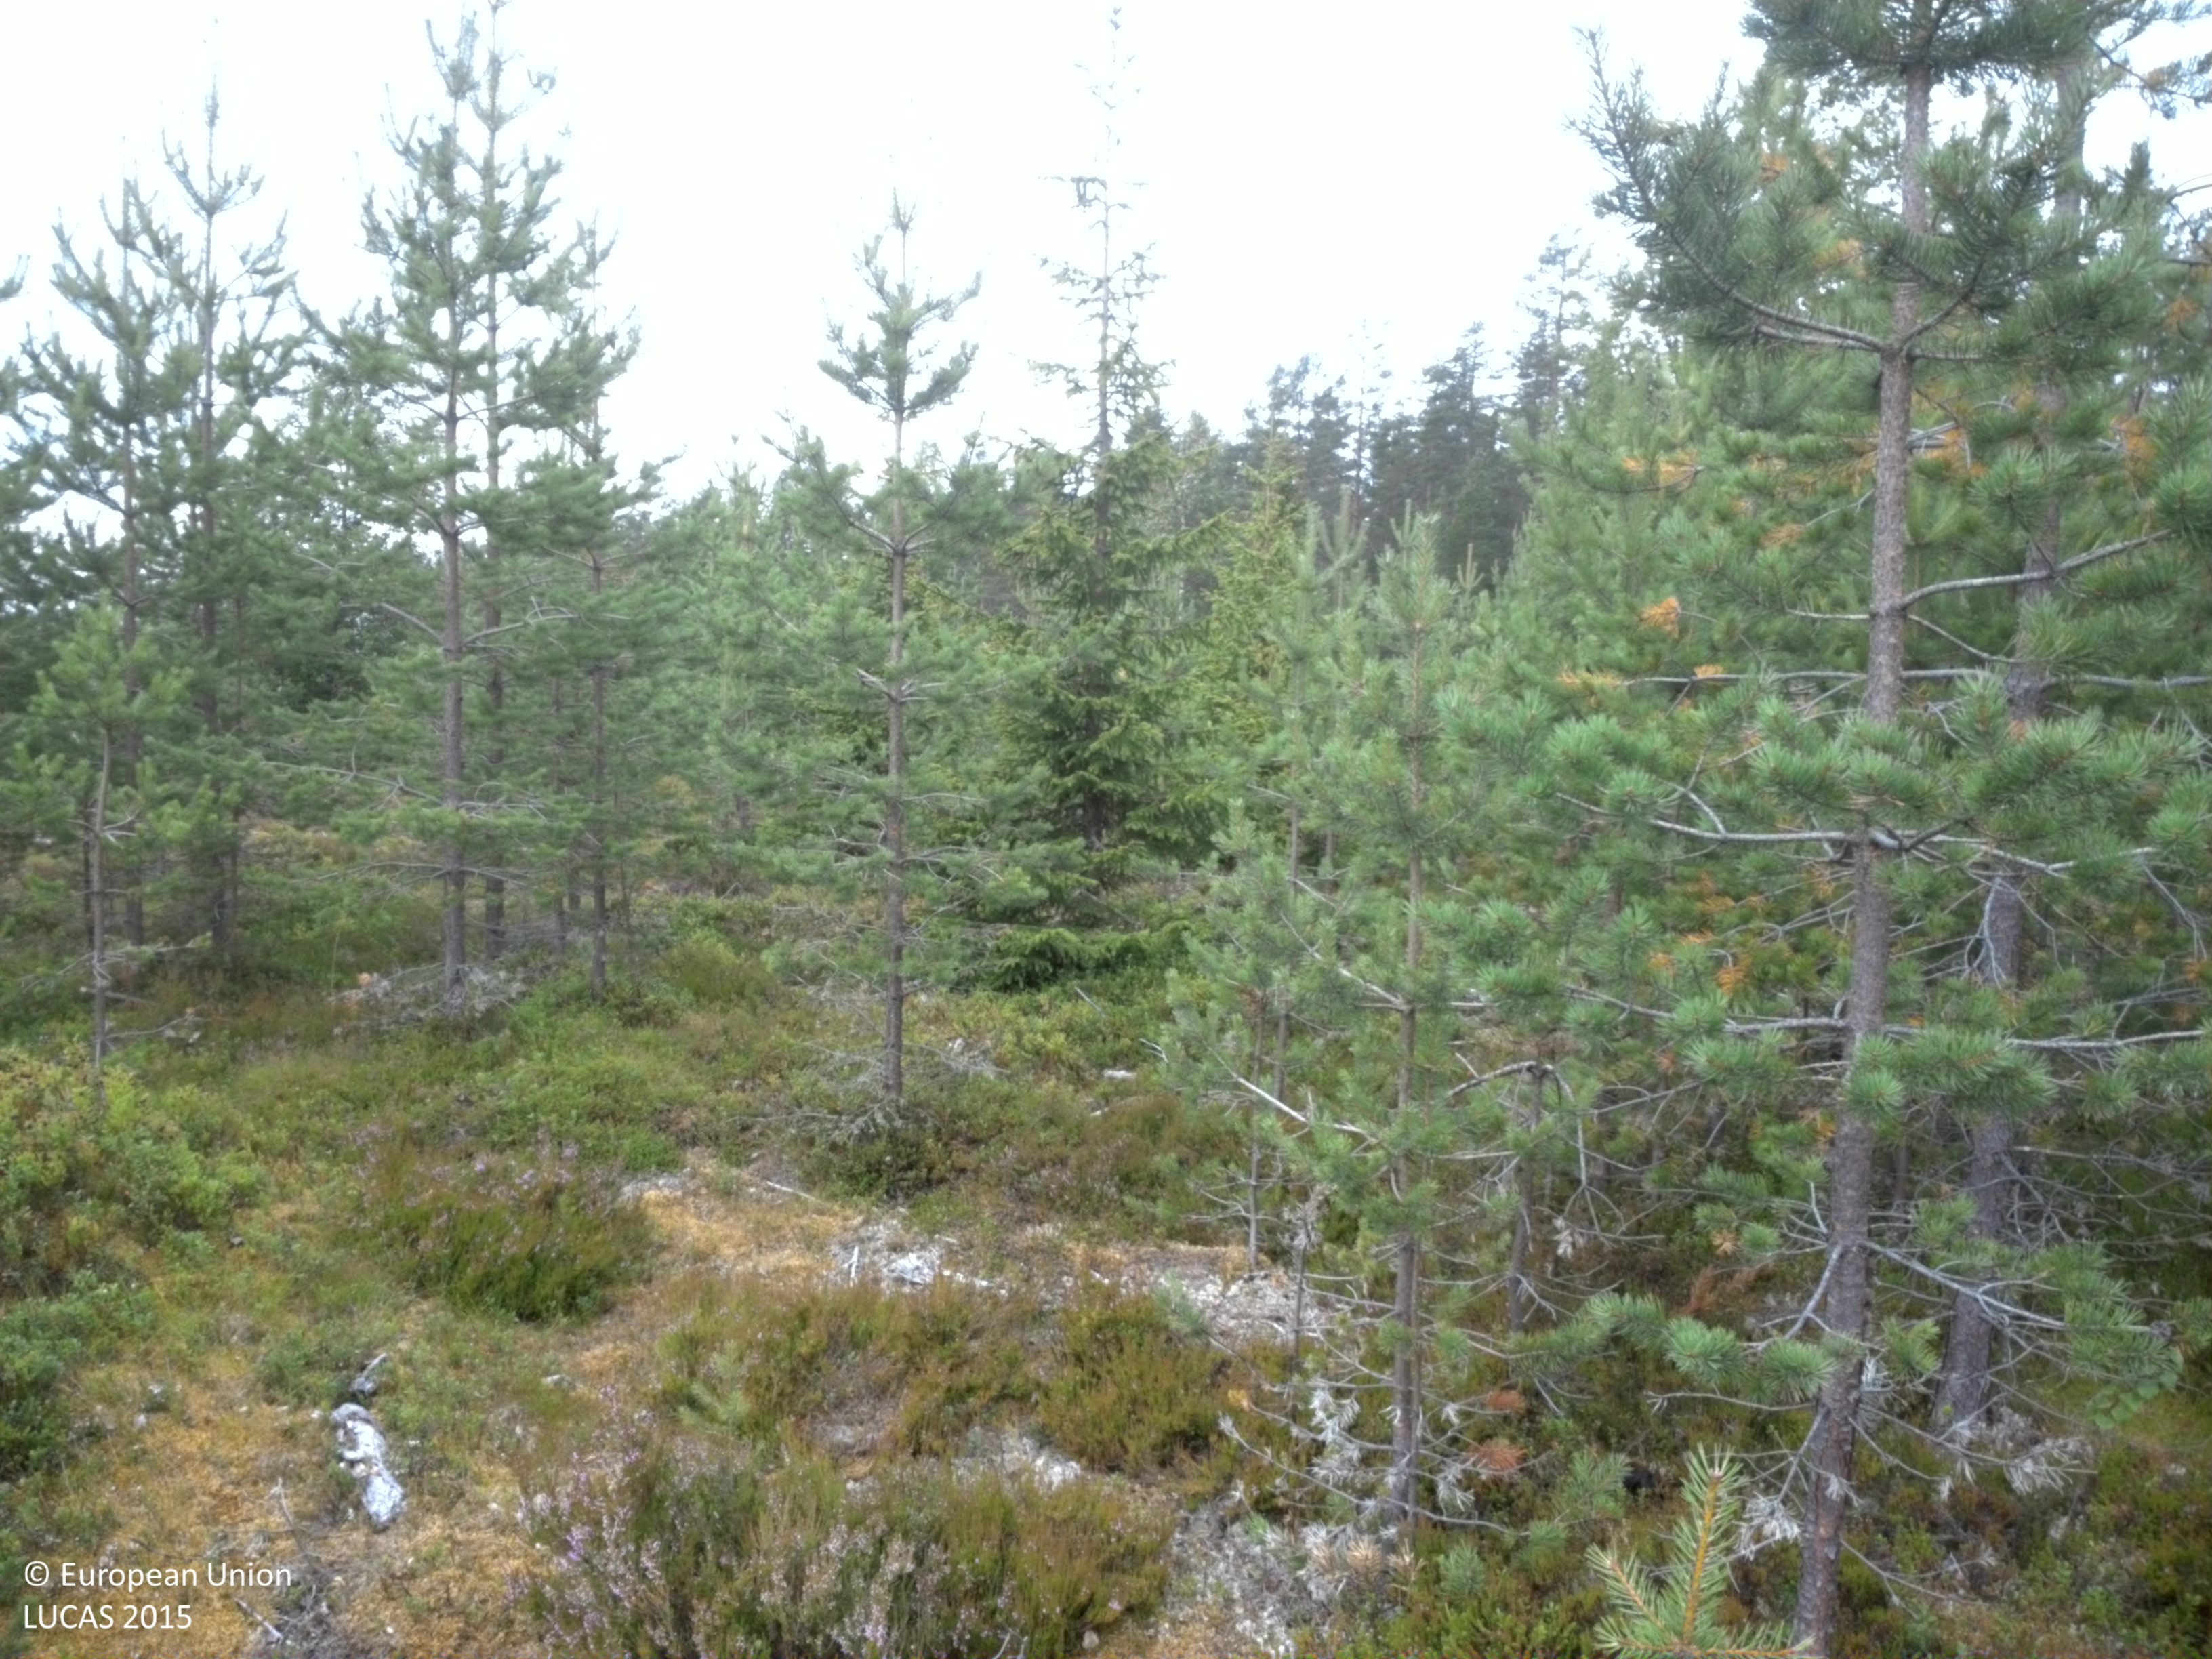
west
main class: Woodland
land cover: Other coniferous woodland
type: boreal forest
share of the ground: 50 - 75 %
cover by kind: coniferous forest trees 50 %, shrubs 35 %, lichens and mosses 10 %, broadleaved forest trees 5 %
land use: Forestry
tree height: > 5 m
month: August
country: SE
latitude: 64.5833
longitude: 20.1437
